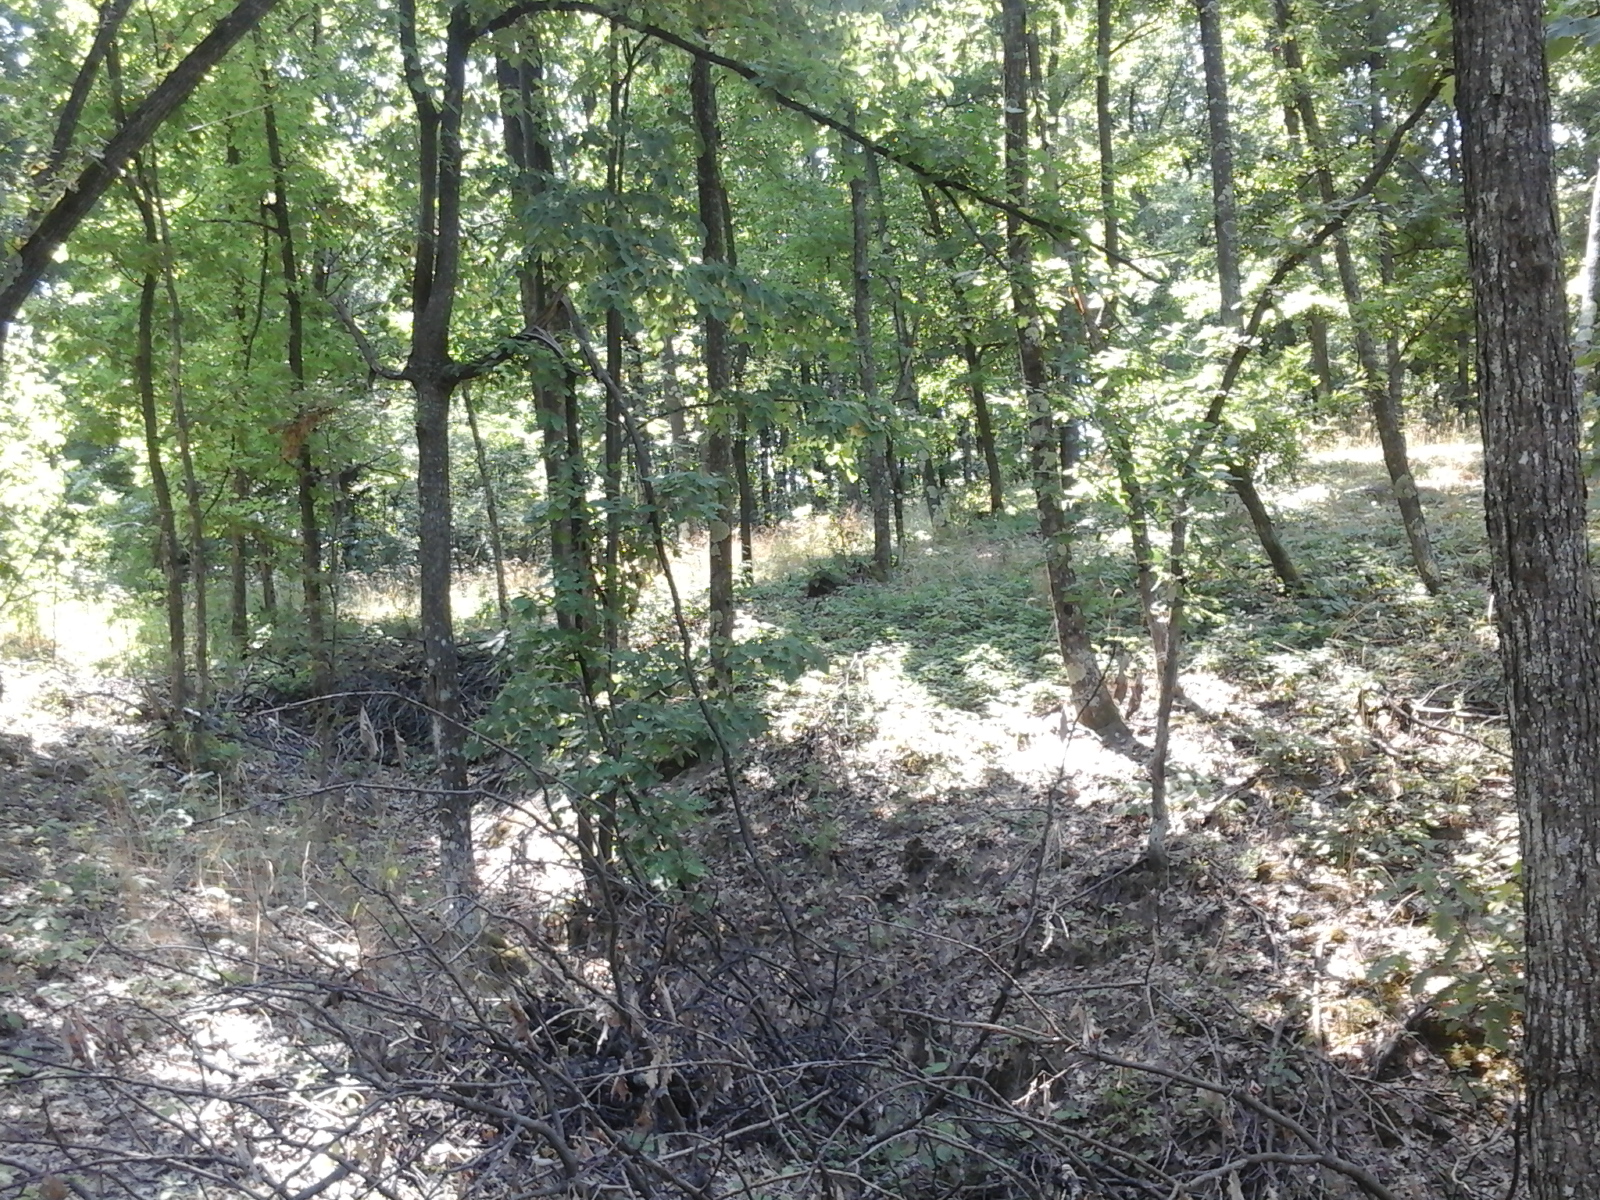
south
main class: Woodland
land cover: Broadleaved woodland
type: acidophilous oak and oak-birch forest
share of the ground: > 75 %
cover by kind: broadleaved forest trees 100 %
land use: Forestry
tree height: > 5 m
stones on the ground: < 10 %
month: August
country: RO
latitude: 44.8048
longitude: 23.8554
